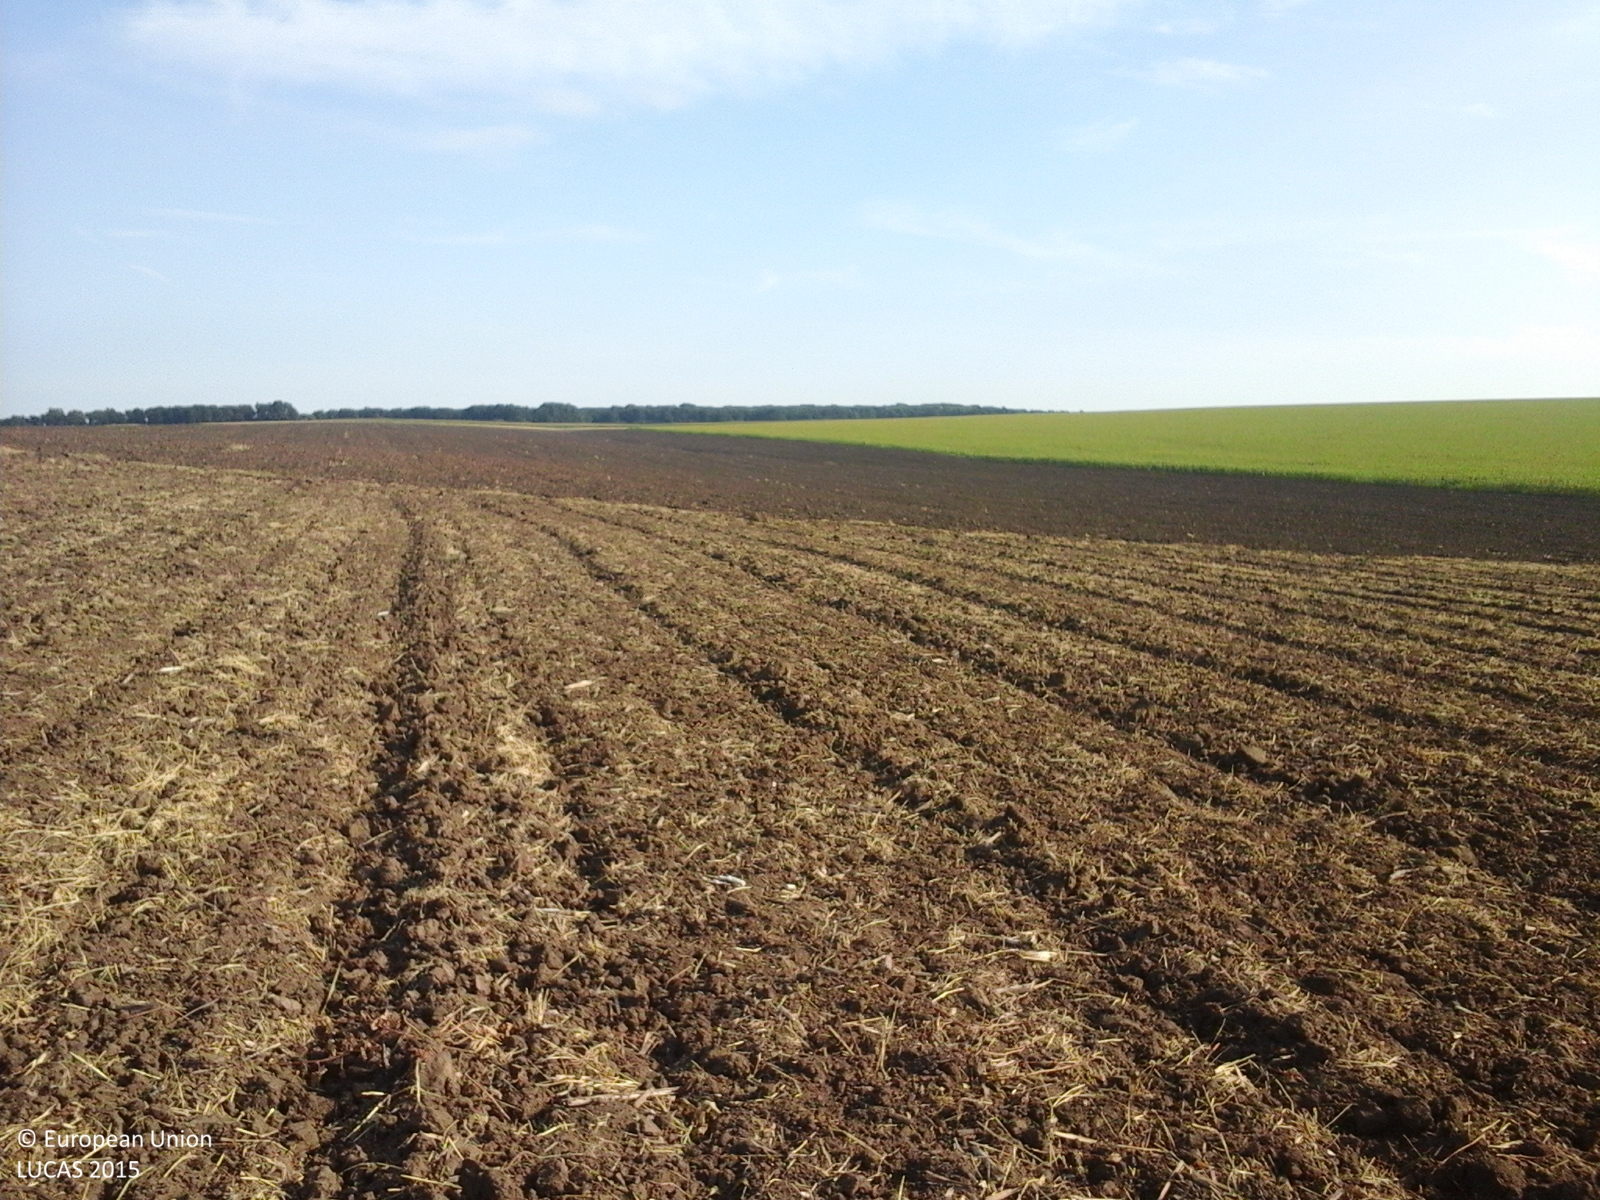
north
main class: Cropland
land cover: Common wheat
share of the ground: < 10 %
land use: Agriculture (excluding fallow land and kitchen gardens)
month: July
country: RO
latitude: 46.0045
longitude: 27.7943
